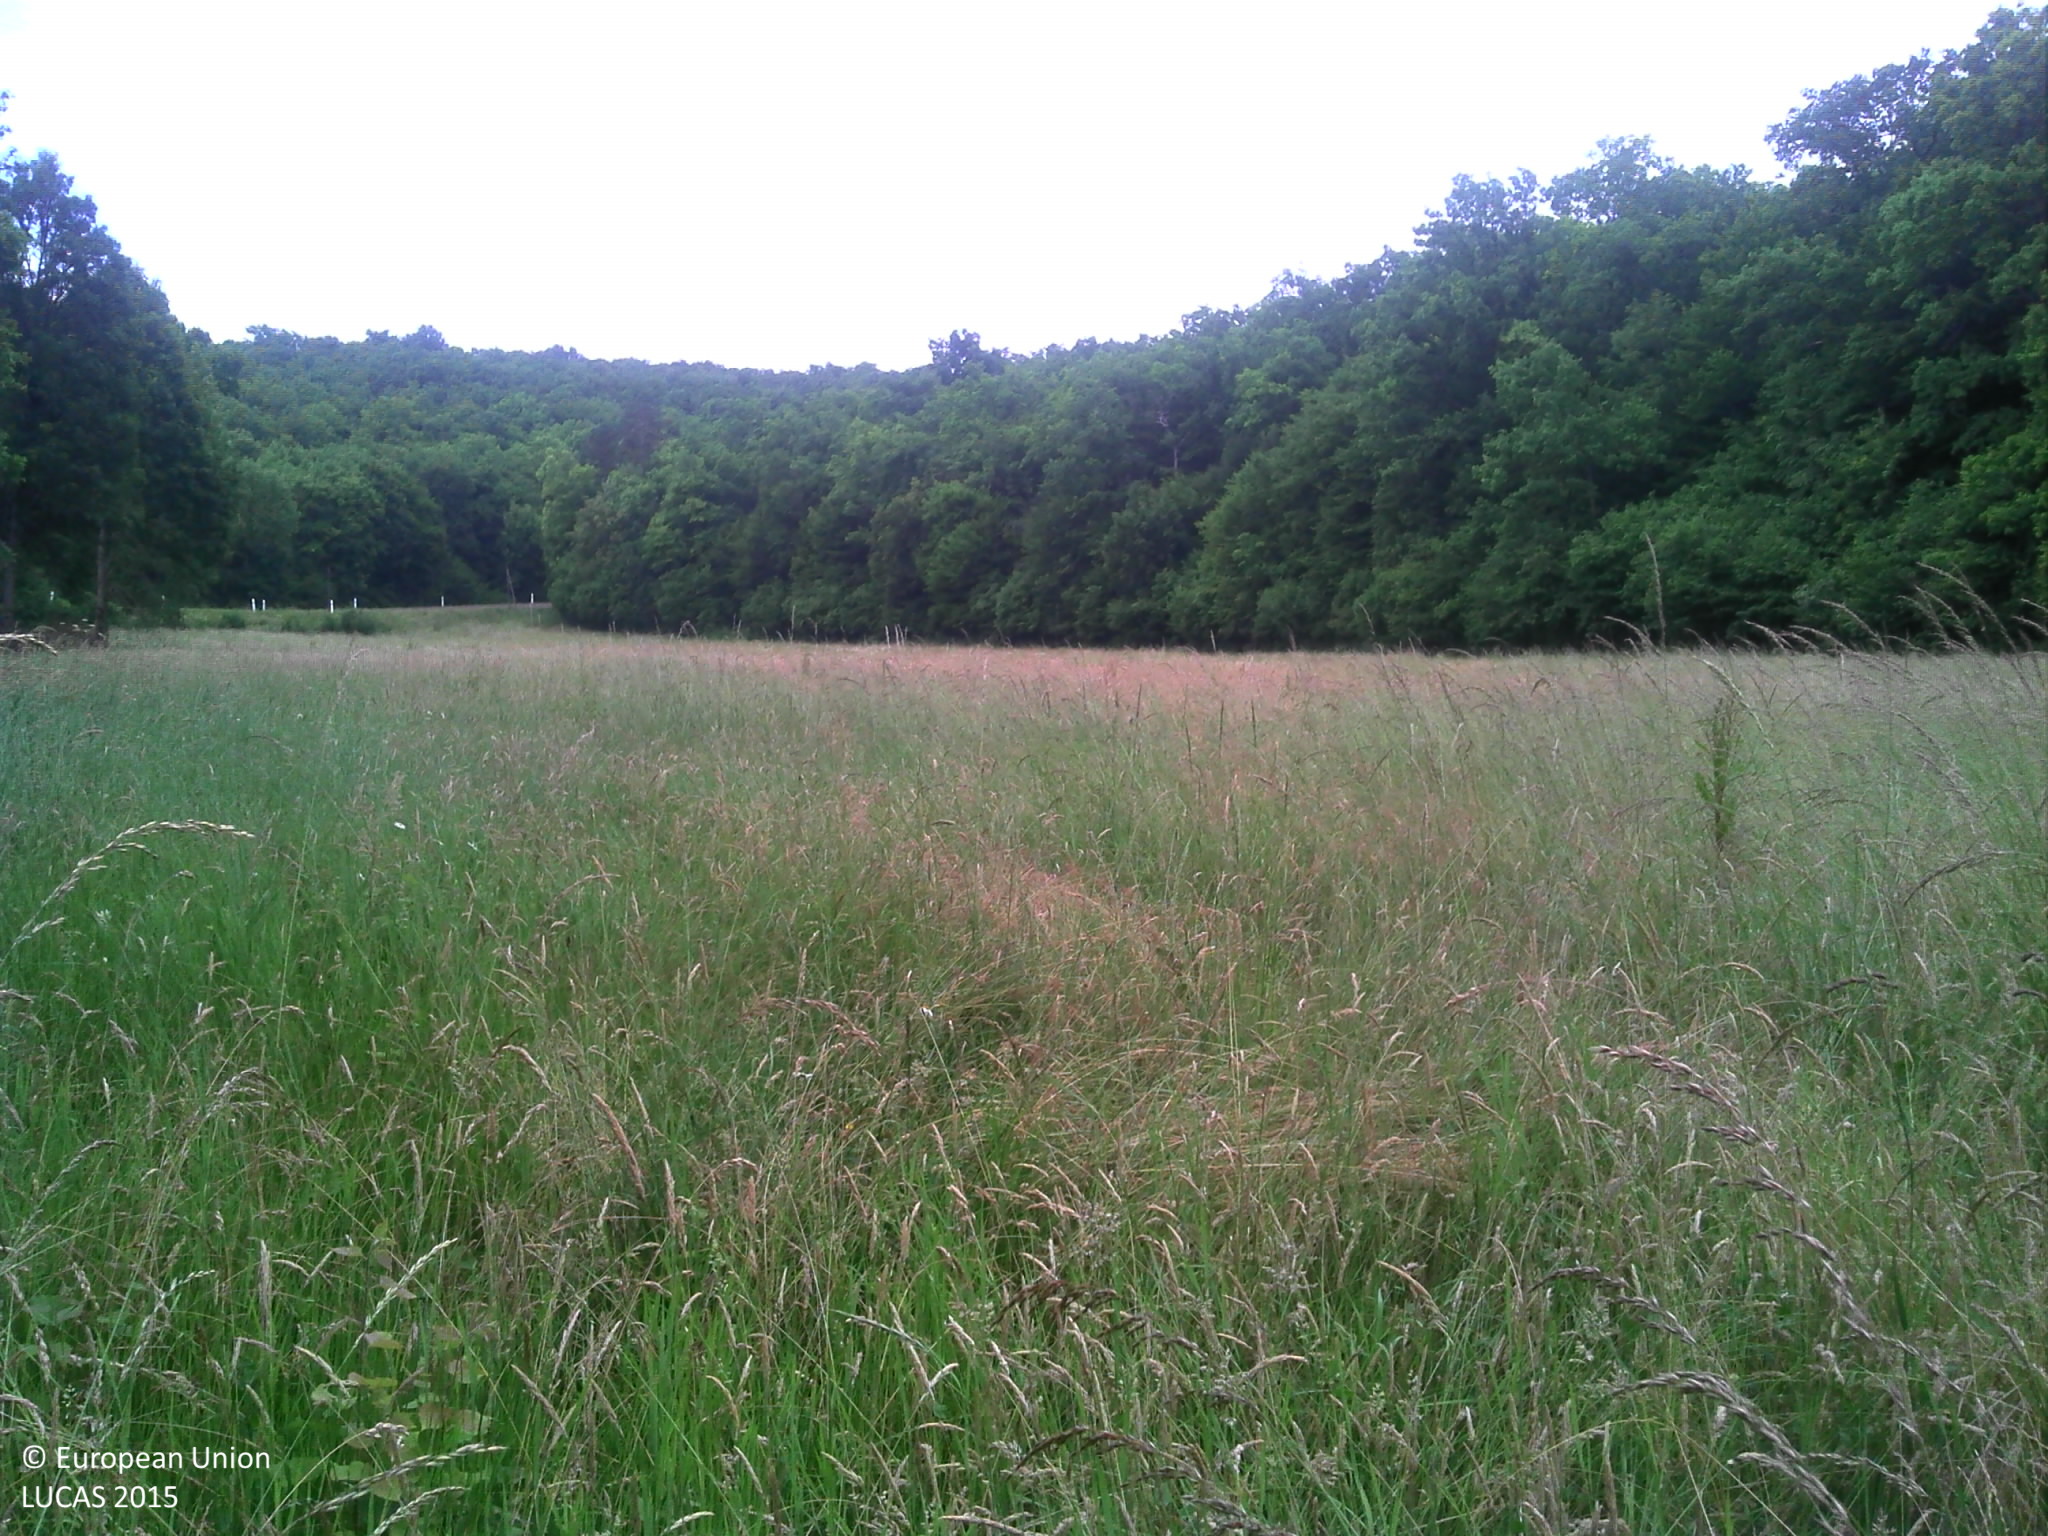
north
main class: Grassland
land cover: Grassland without tree/shrub cover
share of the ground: > 75 %
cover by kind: herbaceous plants 100 %
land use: Agriculture (excluding fallow land and kitchen gardens)
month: June
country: FR
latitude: 48.3380
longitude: 4.8583
